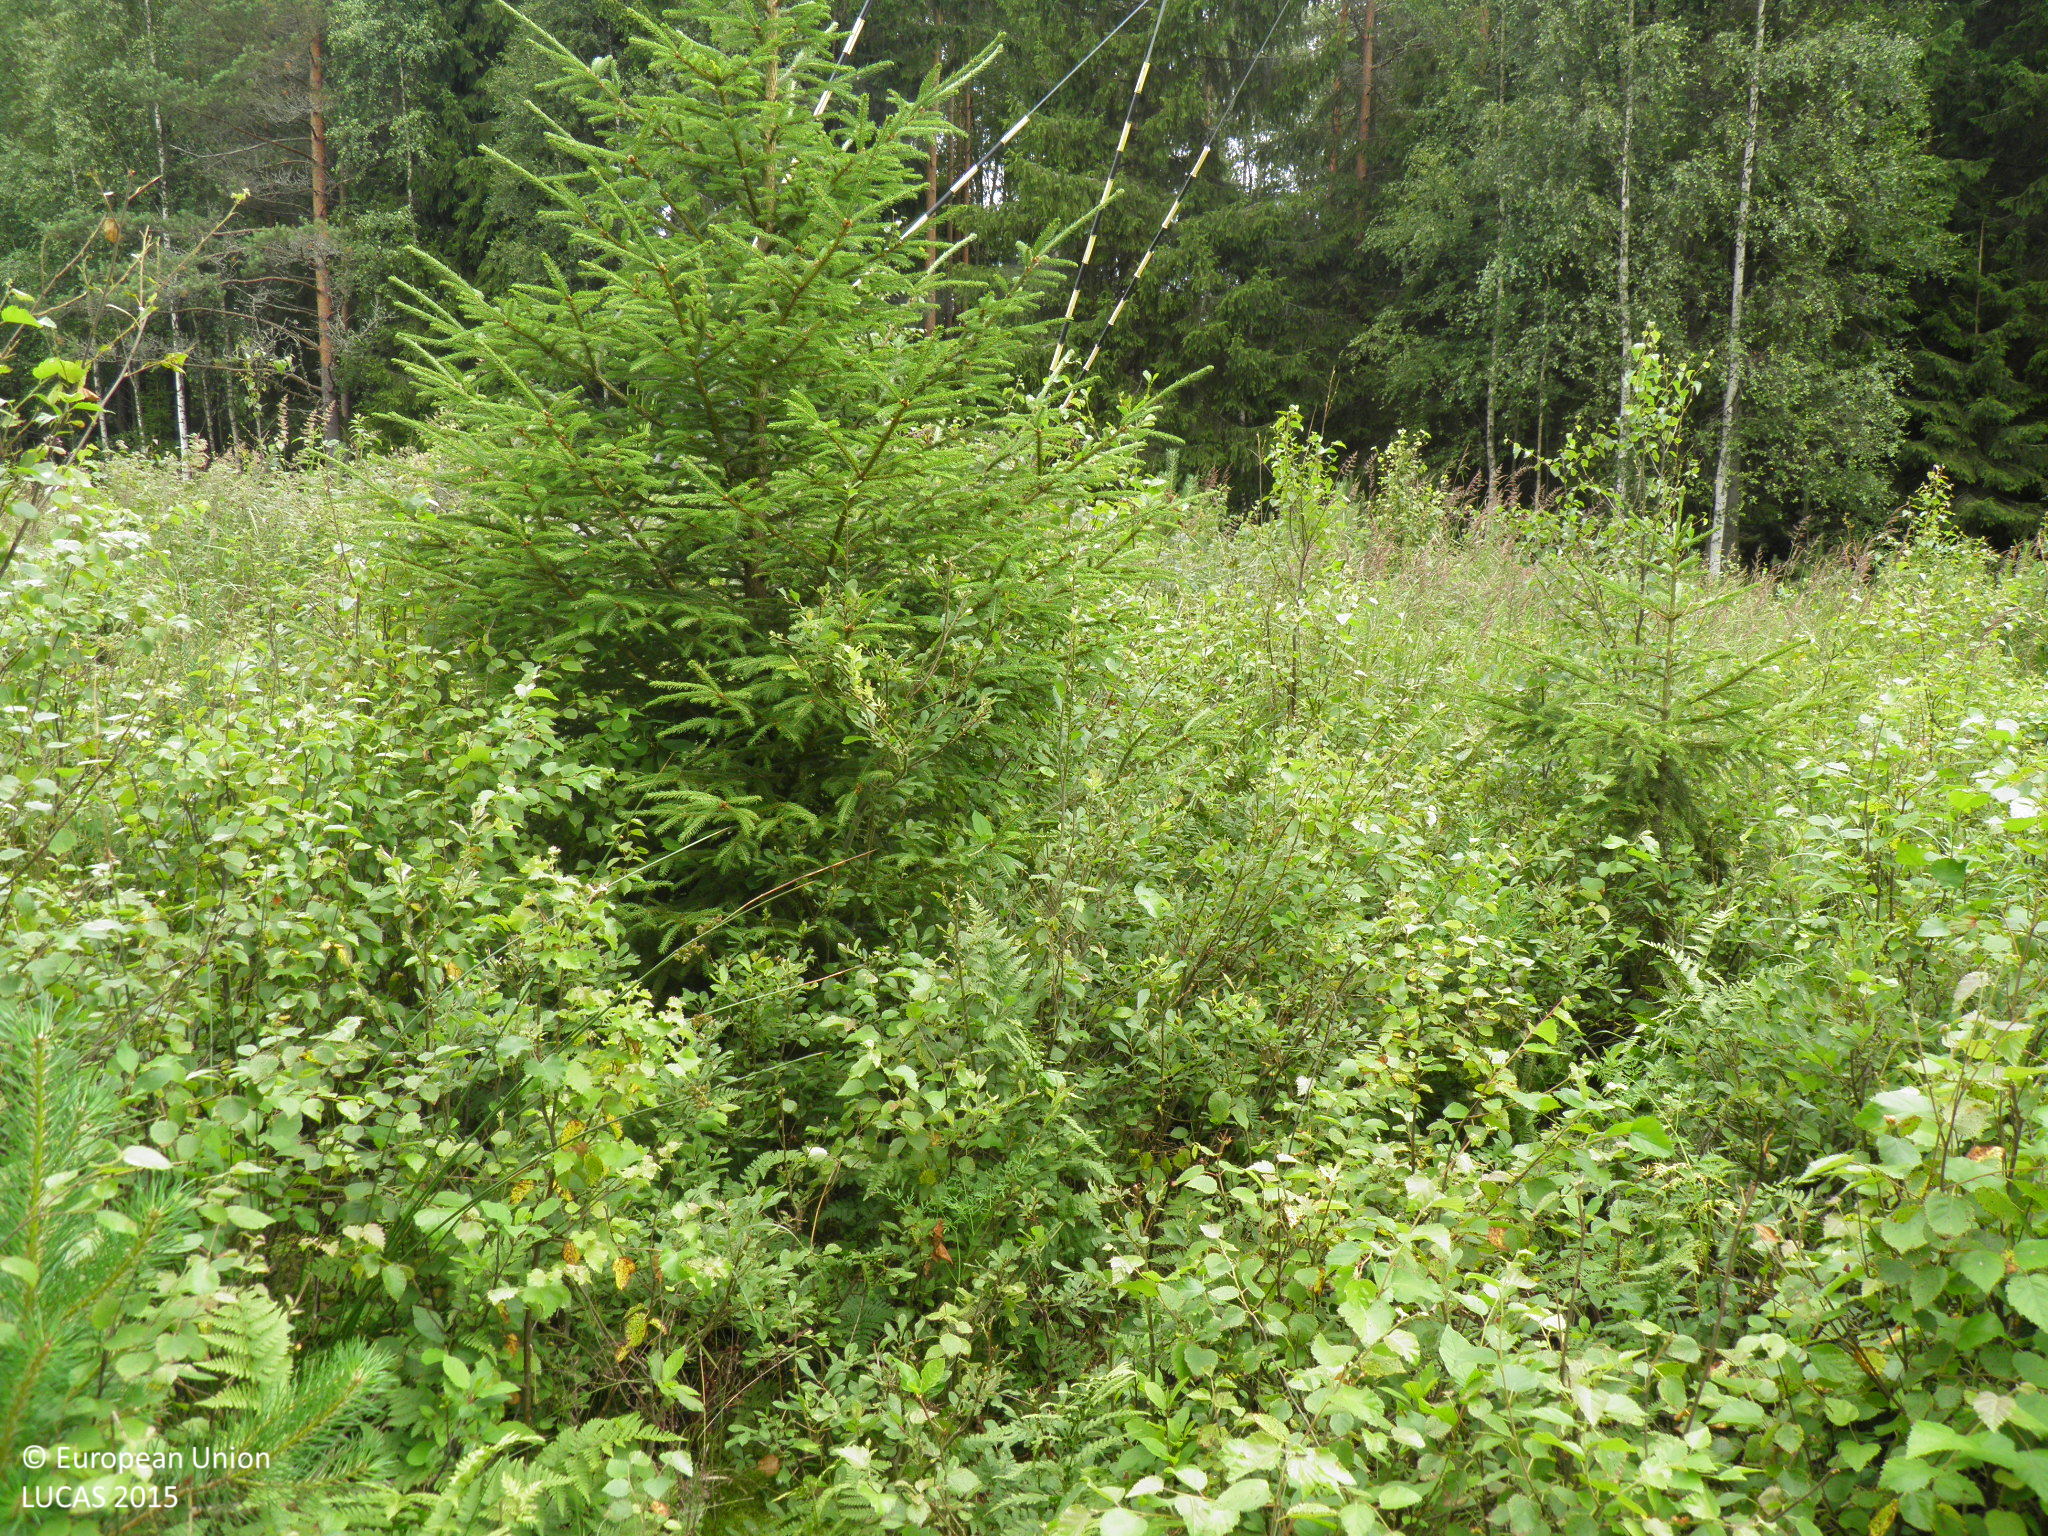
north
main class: Artificial land
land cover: Other artificial areas
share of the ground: > 75 %
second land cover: Shrubland with sparse tree cover
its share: > 75 %
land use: Electricity, gas and thermal power distribution
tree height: < 5 m
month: July
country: FI
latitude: 60.2157
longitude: 22.8004
